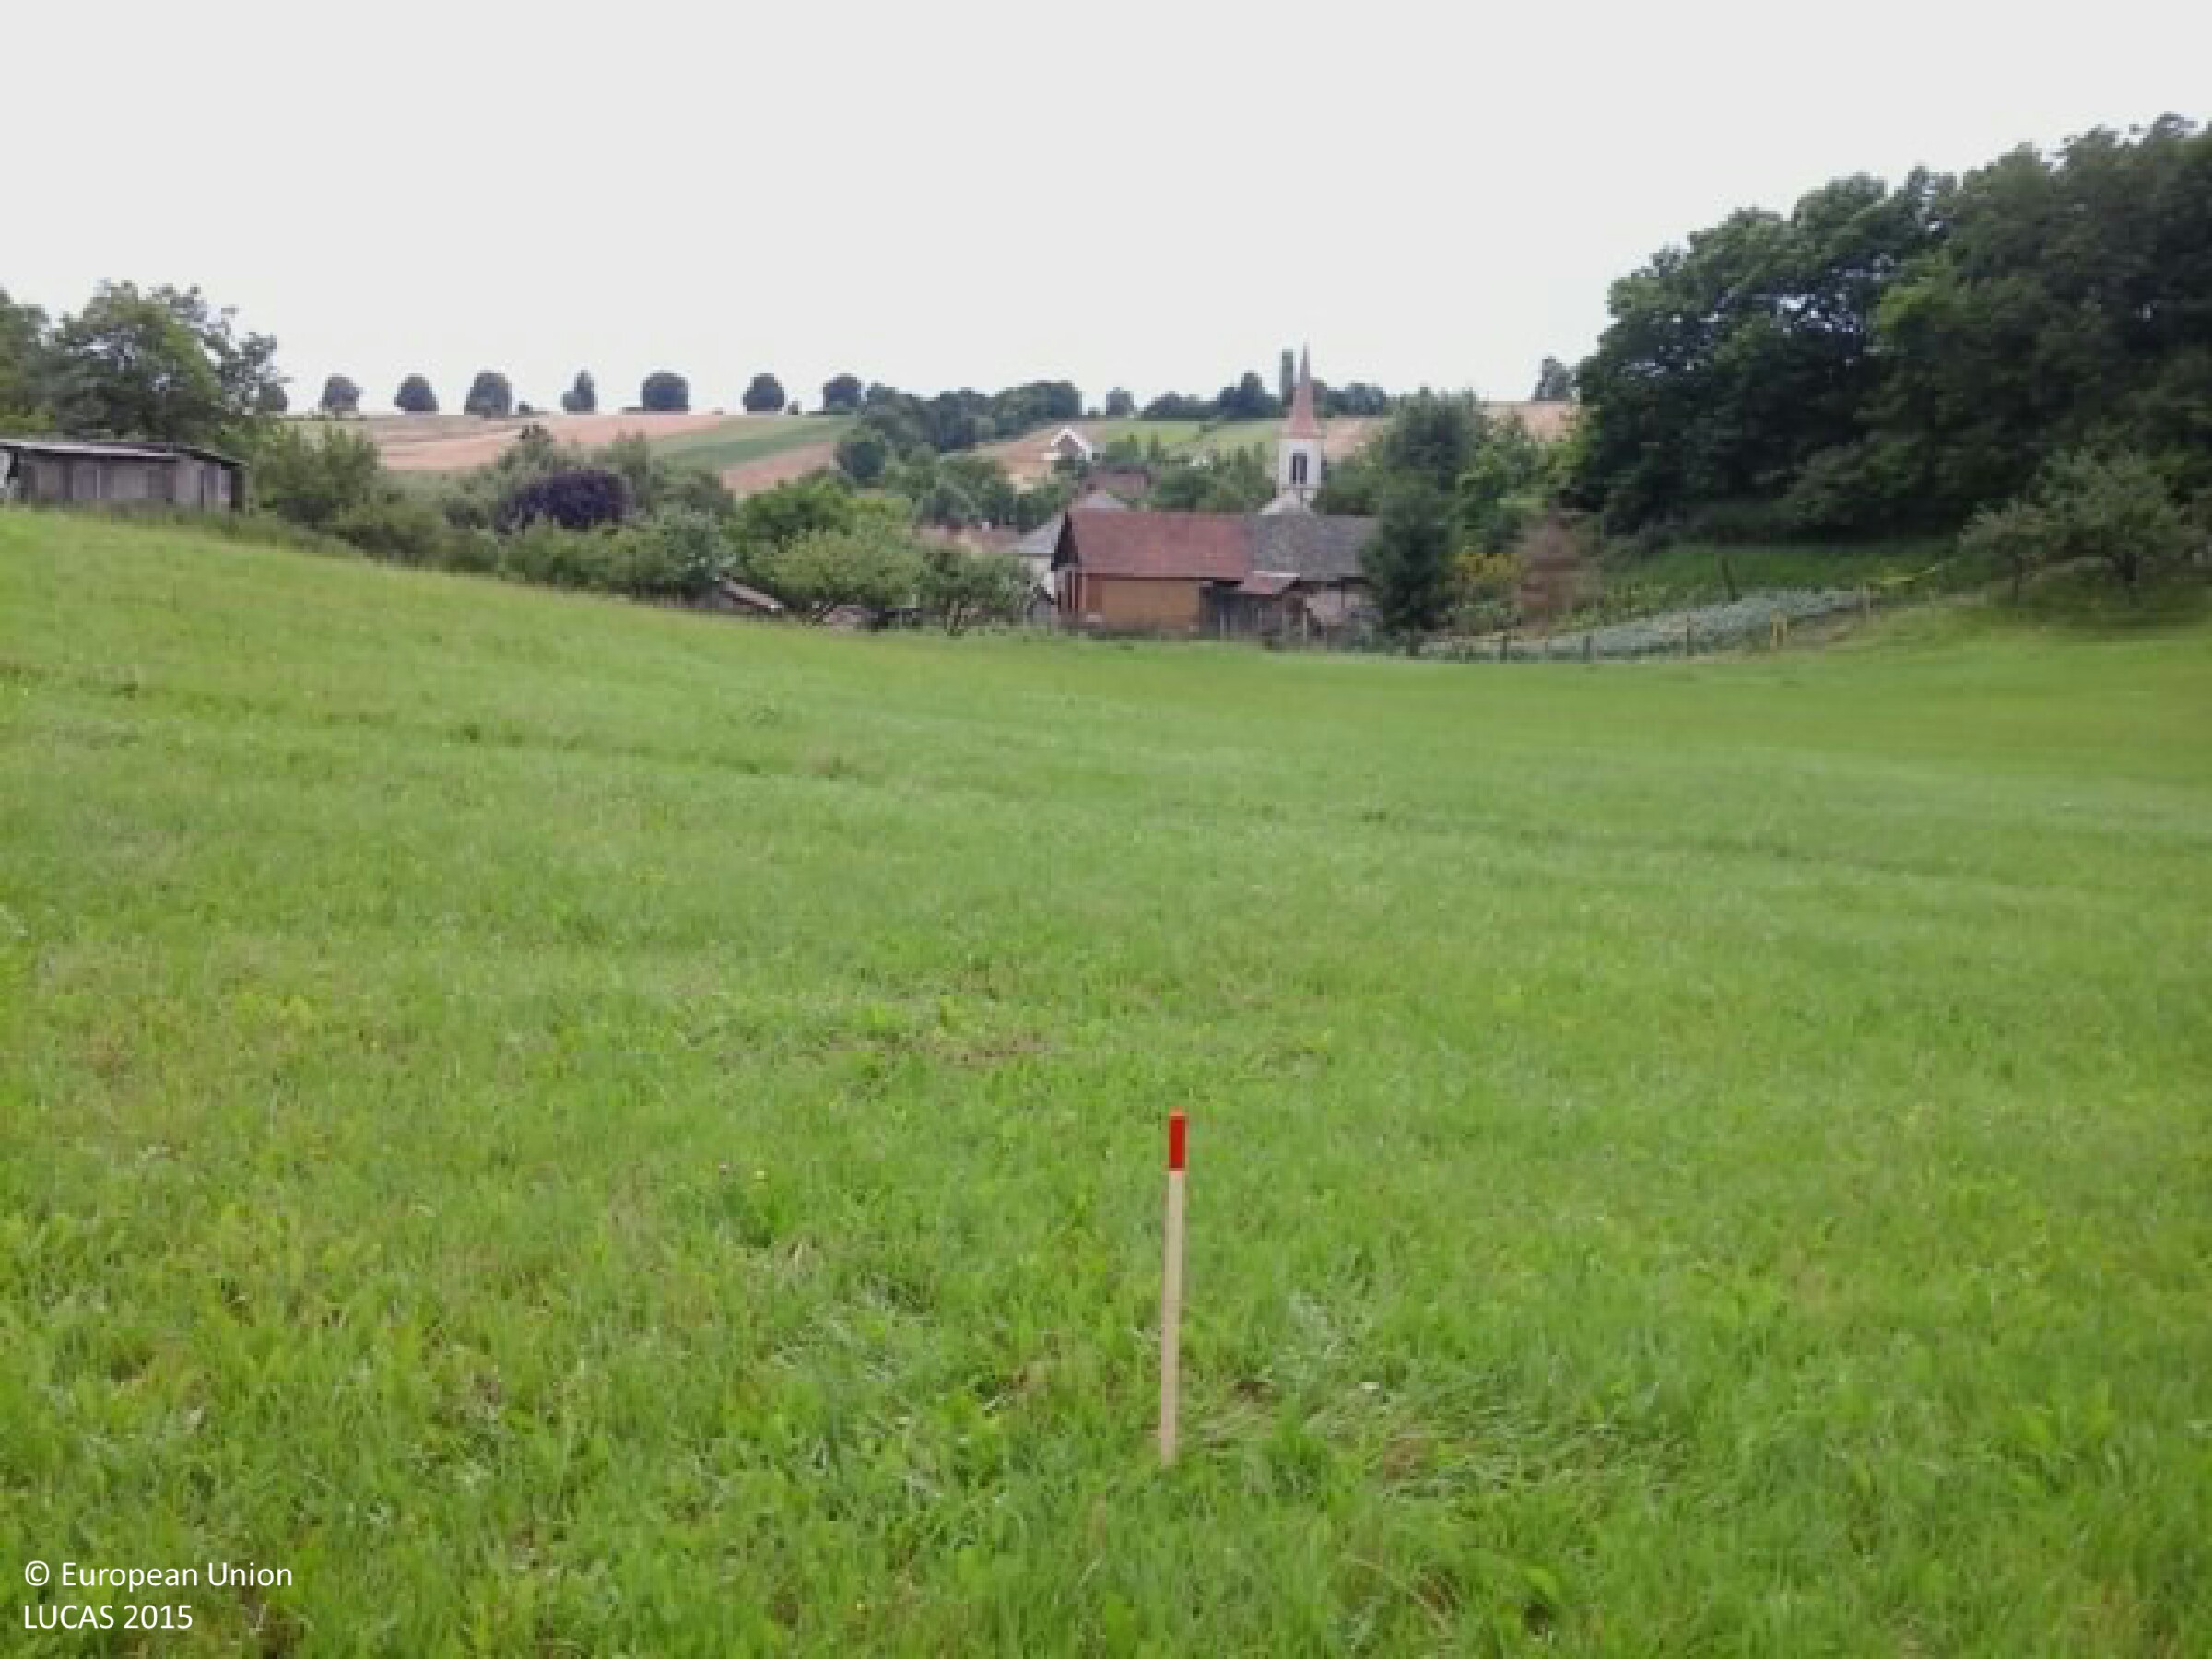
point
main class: Grassland
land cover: Grassland without tree/shrub cover
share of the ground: > 75 %
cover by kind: herbaceous plants 100 %
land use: Agriculture (excluding fallow land and kitchen gardens)
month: June
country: HU
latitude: 46.2432
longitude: 17.8522
